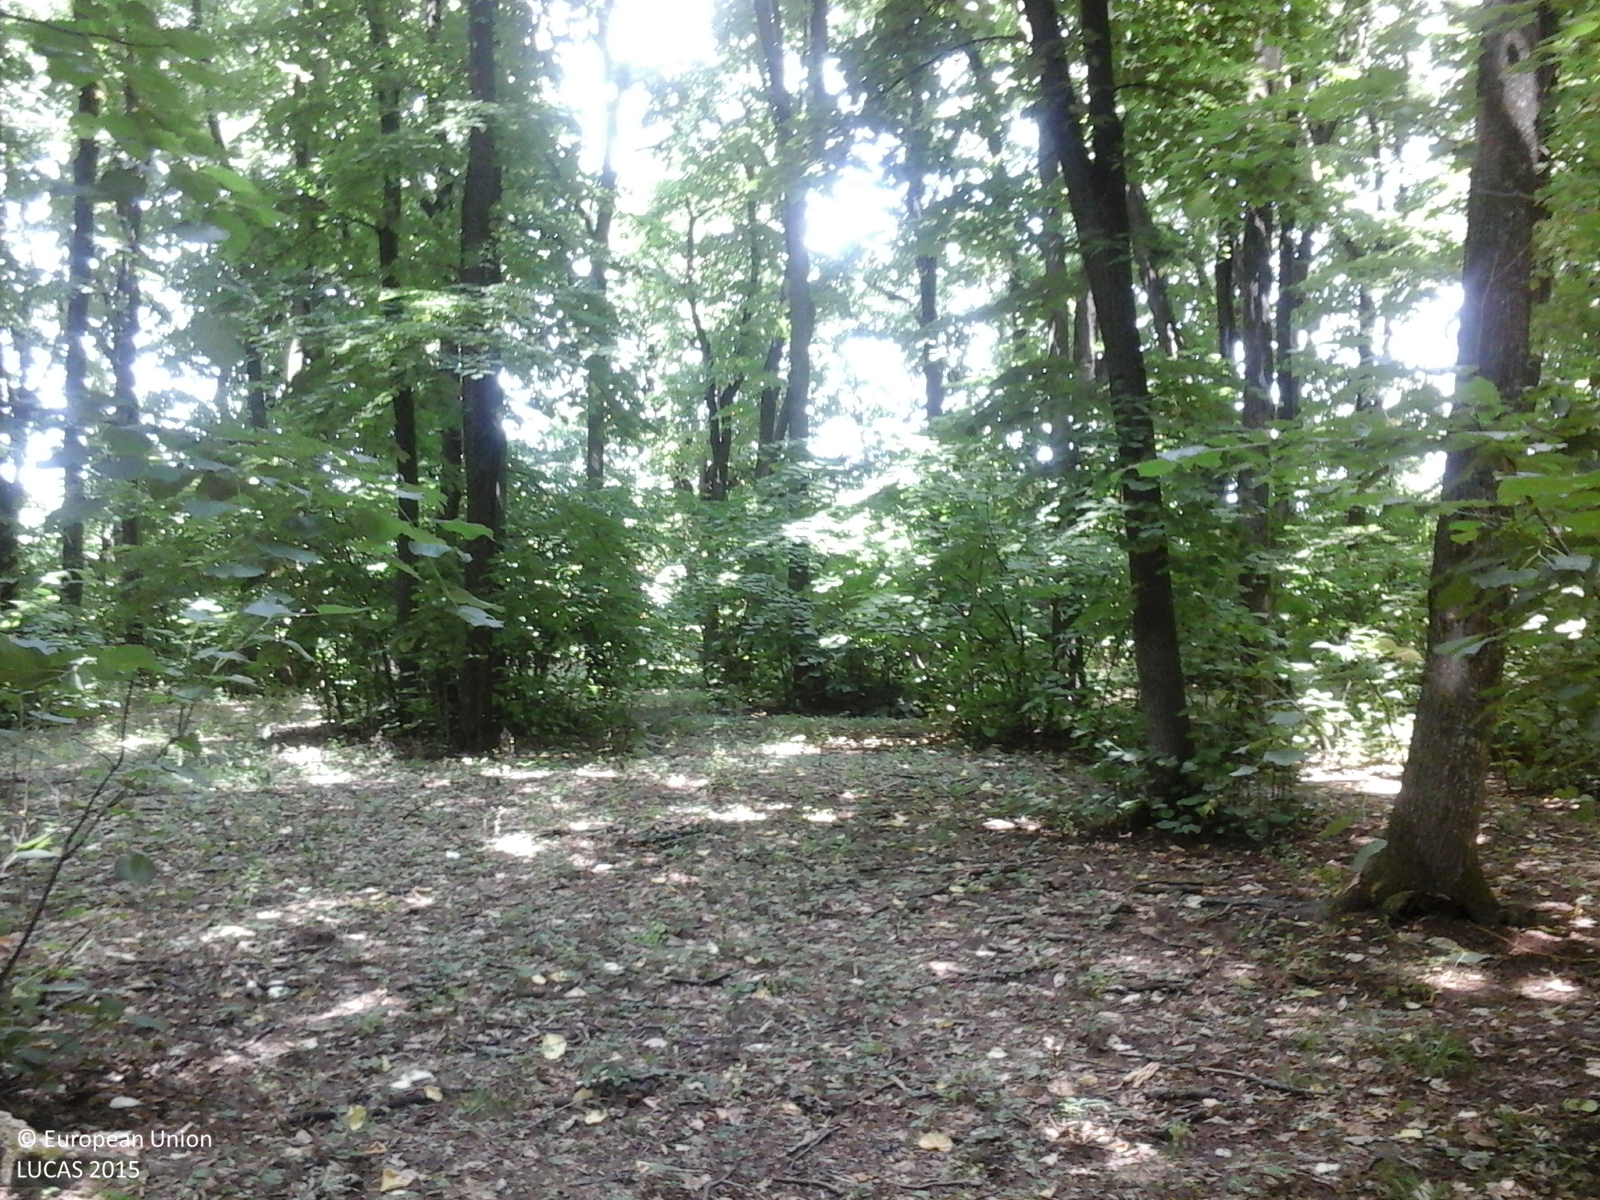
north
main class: Woodland
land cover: Broadleaved woodland
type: thermophilous deciduous forest
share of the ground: > 75 %
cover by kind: broadleaved forest trees 100 %
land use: Forestry
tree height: > 5 m
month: June
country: RO
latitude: 44.1537
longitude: 26.2986
